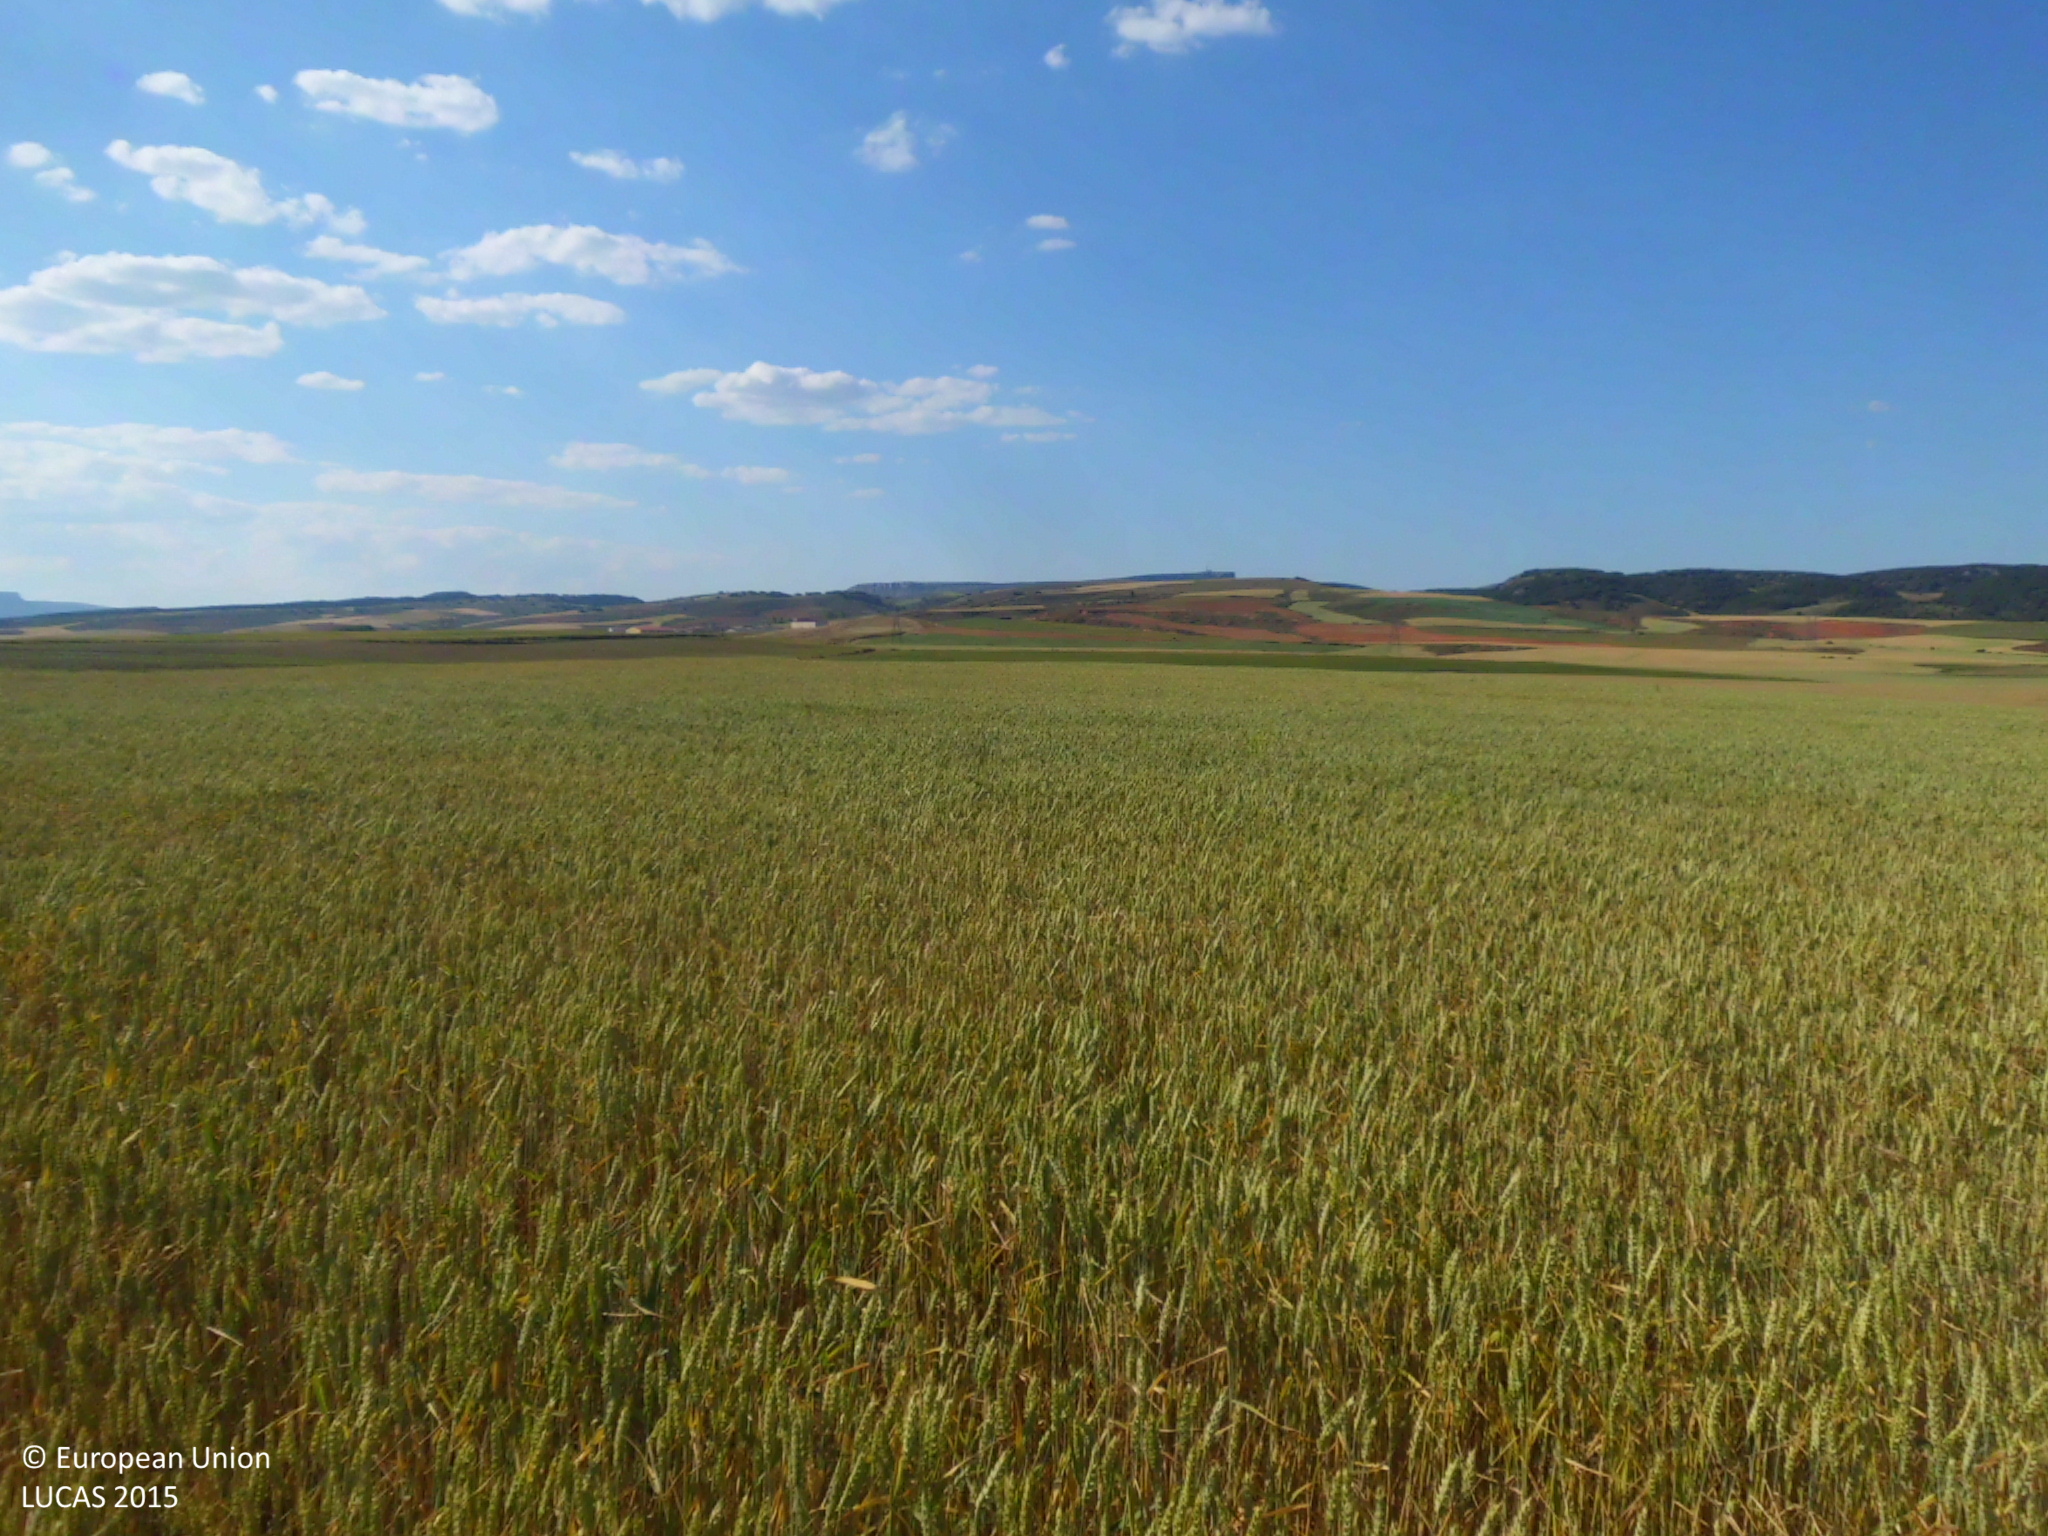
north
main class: Cropland
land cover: Common wheat
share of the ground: > 75 %
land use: Agriculture (excluding fallow land and kitchen gardens)
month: June
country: ES
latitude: 42.5706
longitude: -4.0167
